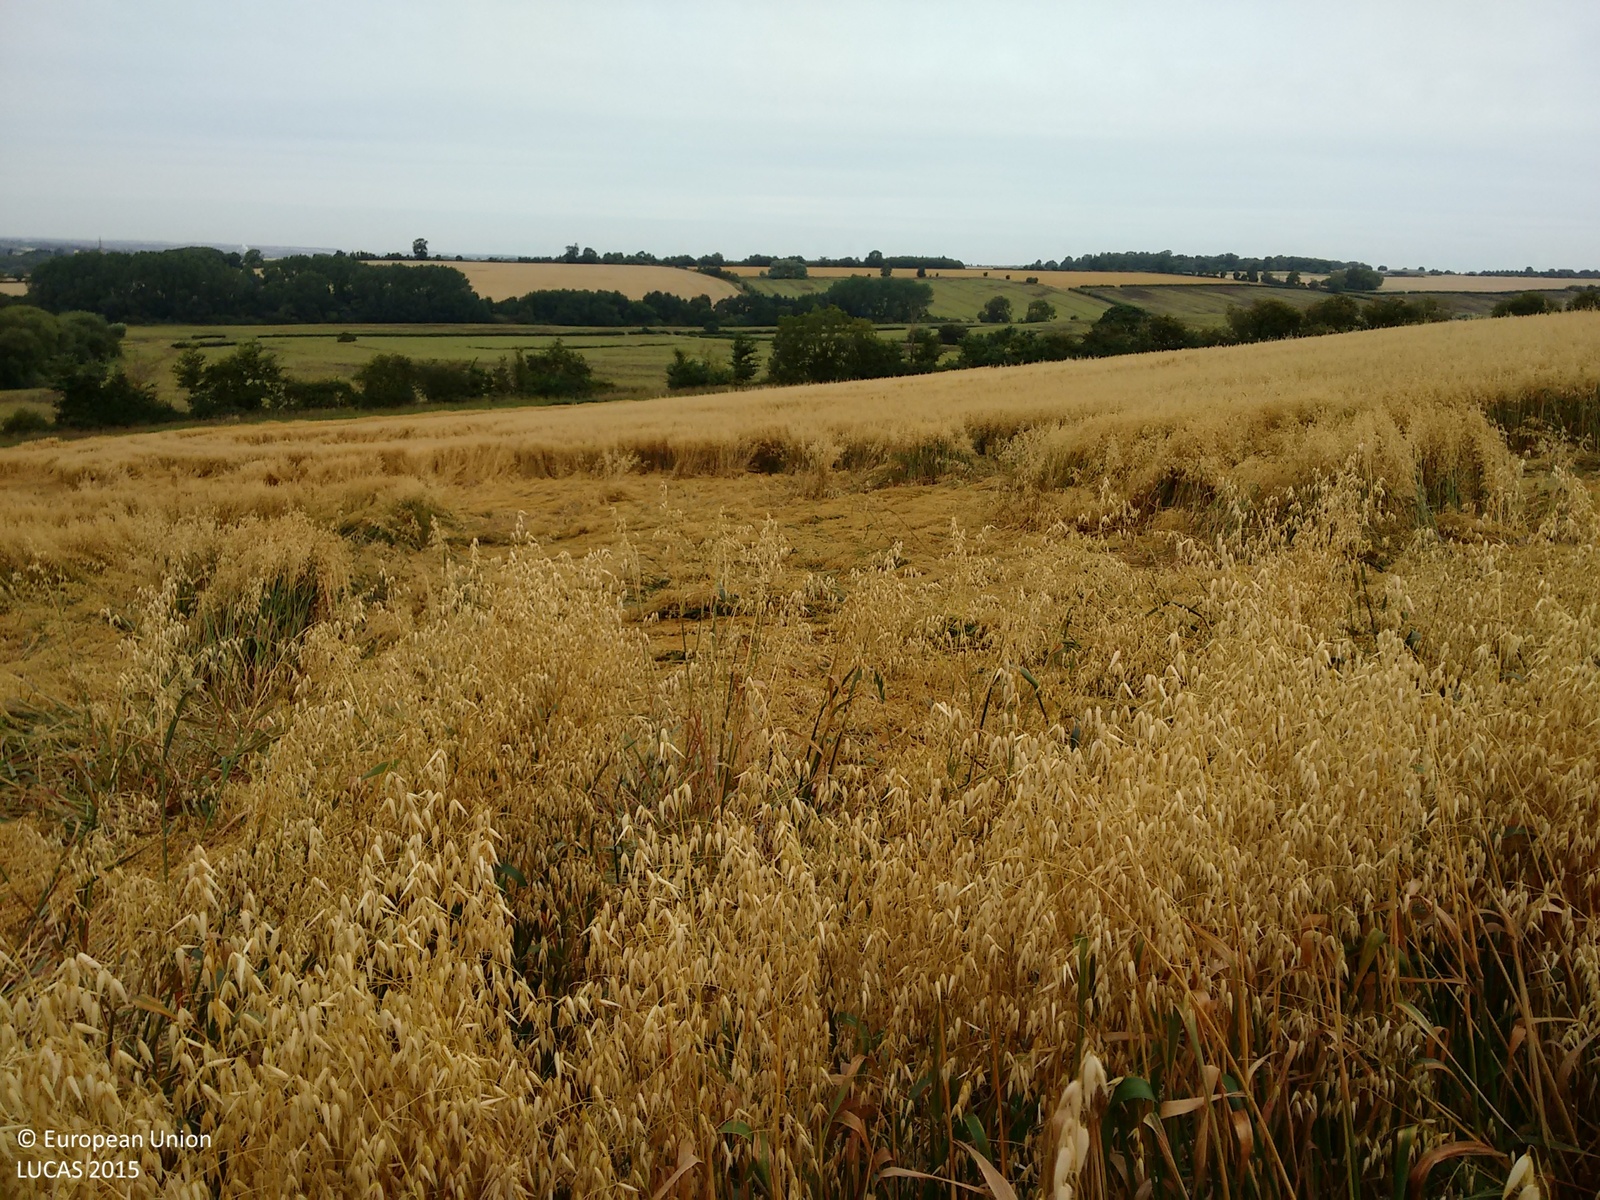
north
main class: Woodland
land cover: Broadleaved woodland
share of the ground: > 75 %
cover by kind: broadleaved forest trees 95 %, shrubs 5 %
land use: Semi-natural and natural areas not in use
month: August
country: GB
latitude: 52.0042
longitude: -1.2499
